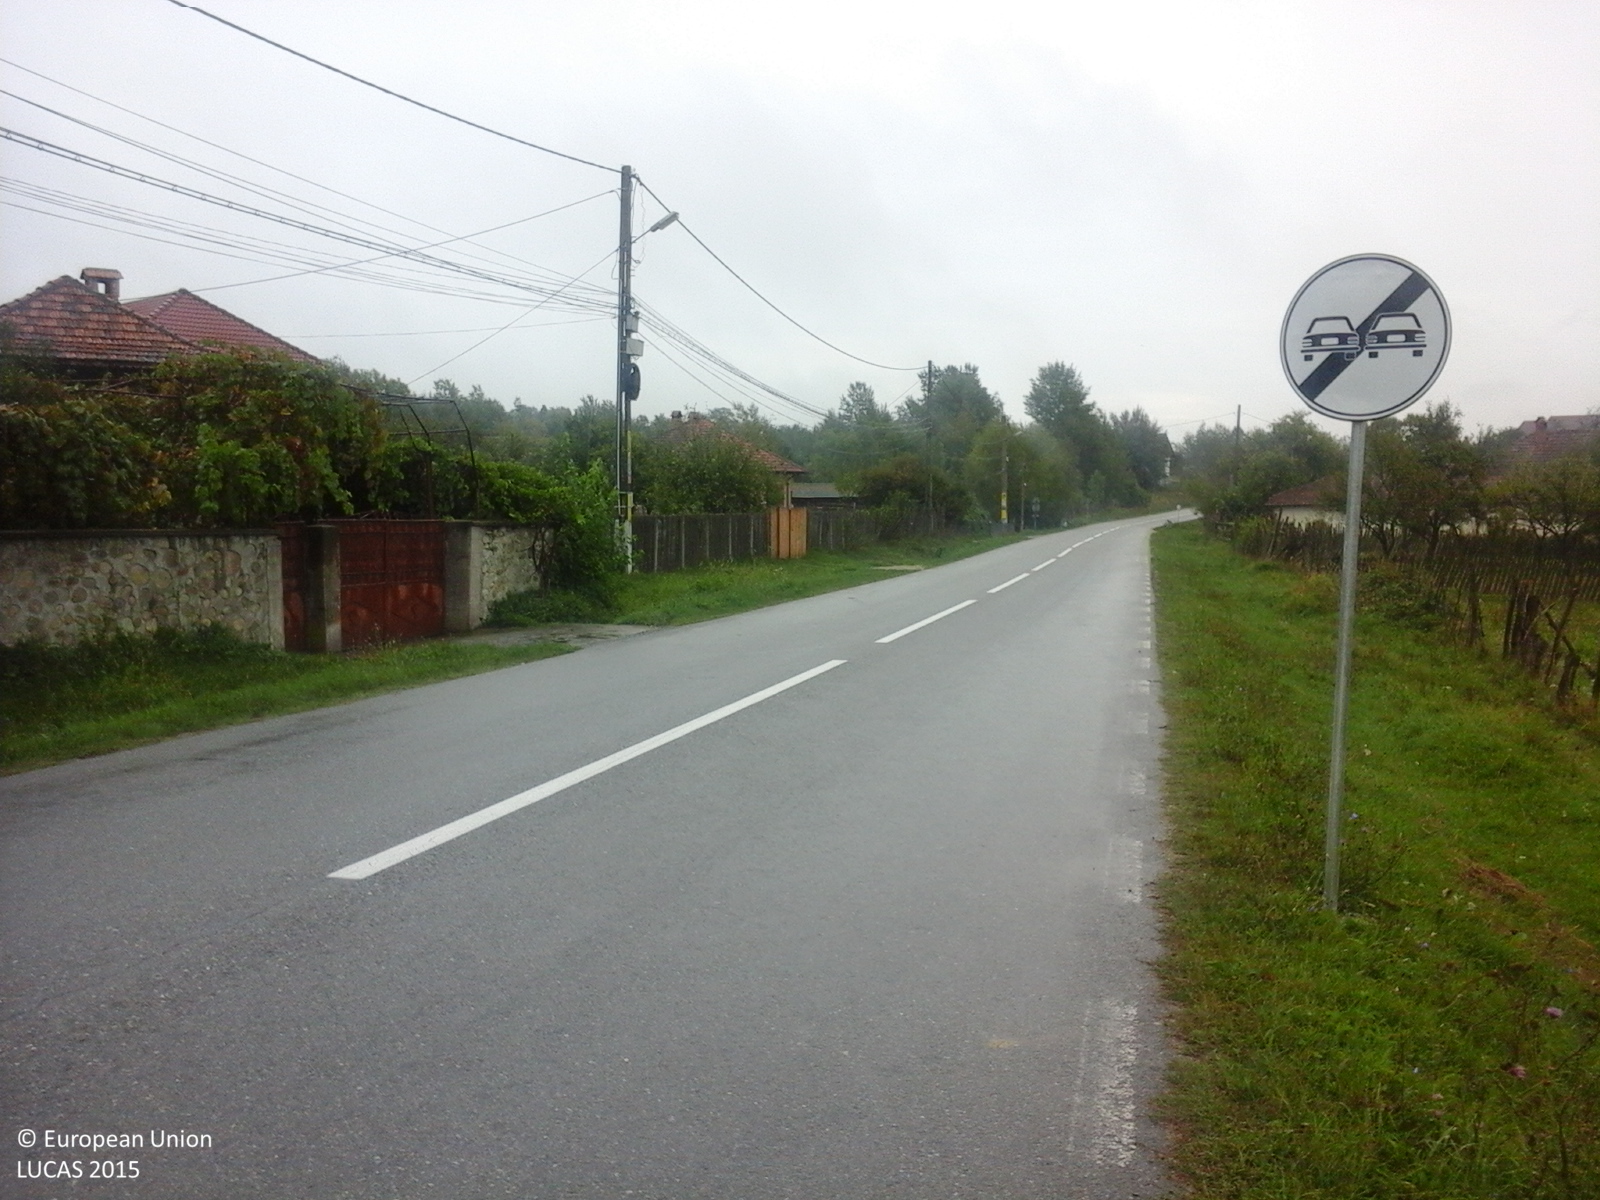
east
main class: Cropland
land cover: Vineyards
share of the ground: 10 - 25 %
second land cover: Grassland without tree/shrub cover
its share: > 75 %
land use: Kitchen garden
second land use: Residential
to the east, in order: Vineyards; Grassland without tree/shrub cover; Artificial constructions in urban areas; Grassland without tree/shrub cover; Abandoned hedges; Grassland without tree/shrub cover; Artificial constructions in urban areas; Grassland without tree/shrub cover; Fences; Grassland without tree/shrub cover; Permanent crops (only in case pi)
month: September
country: RO
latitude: 45.1660
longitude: 23.6101
